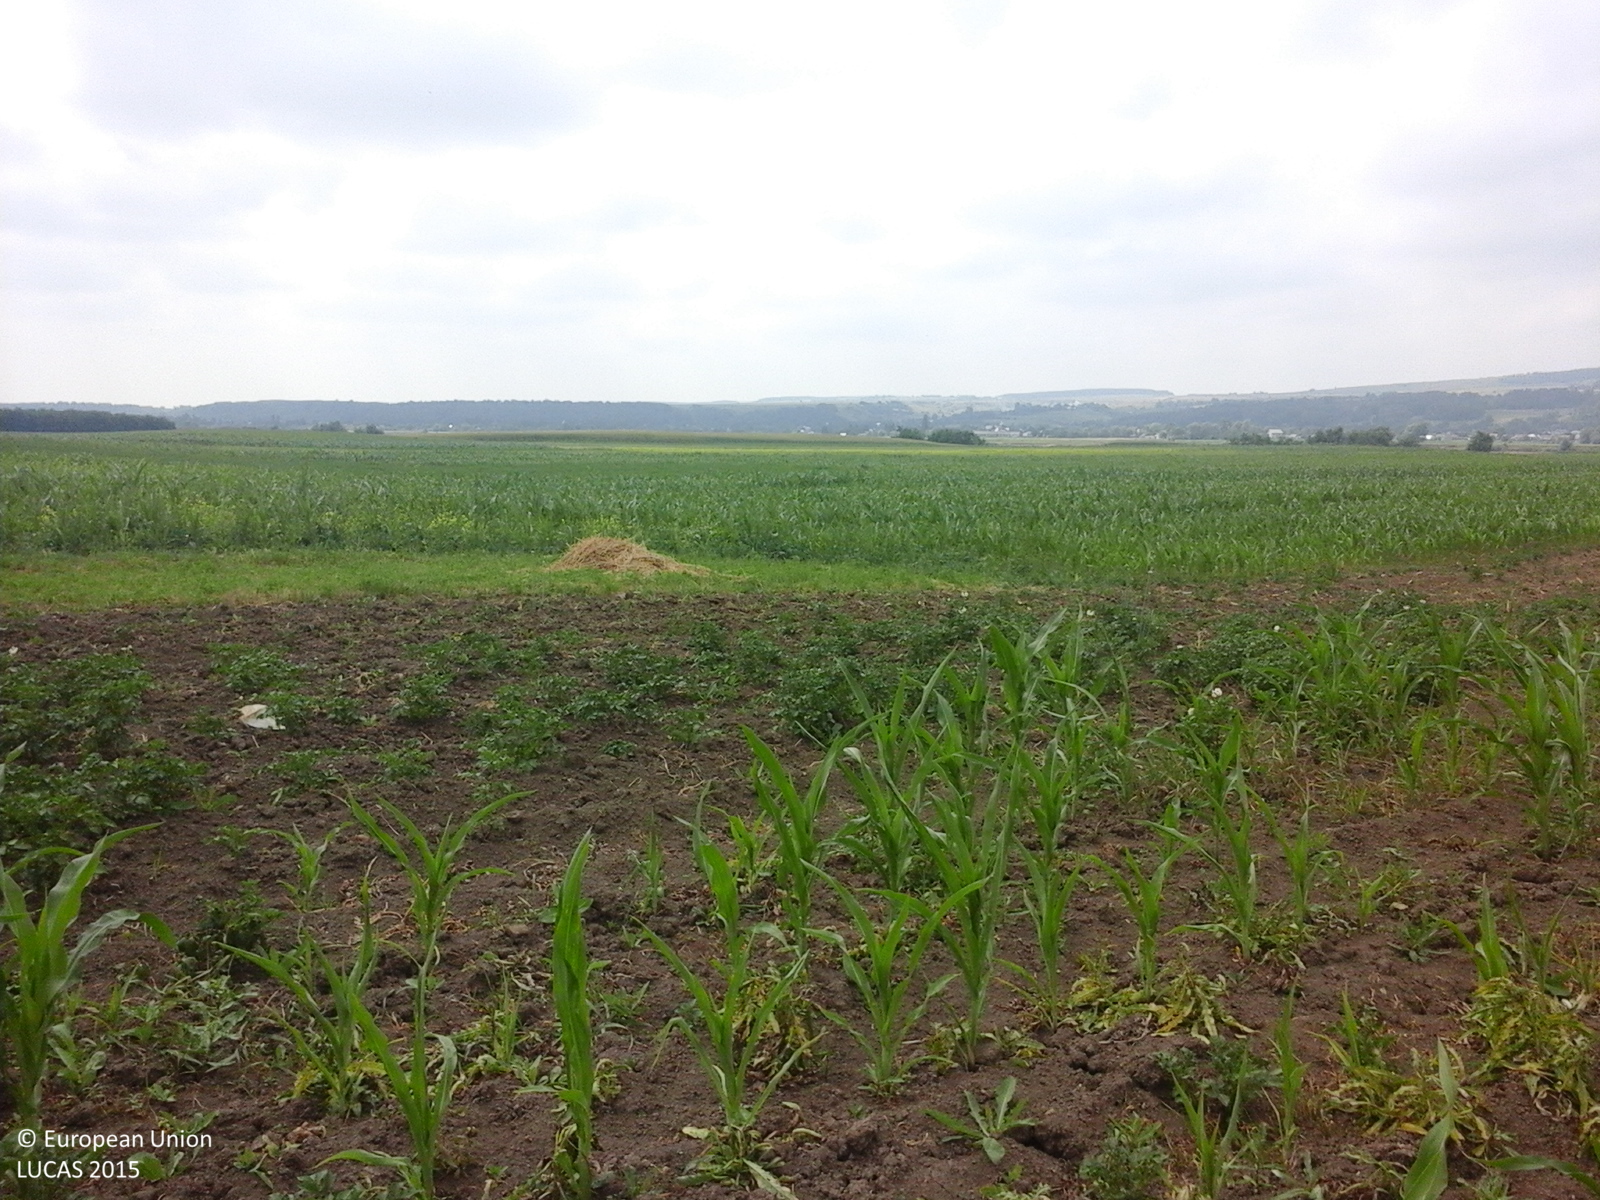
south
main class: Cropland
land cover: Maize
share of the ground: 25 - 50 %
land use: Agriculture (excluding fallow land and kitchen gardens)
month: June
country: RO
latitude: 47.5776
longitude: 26.4813
